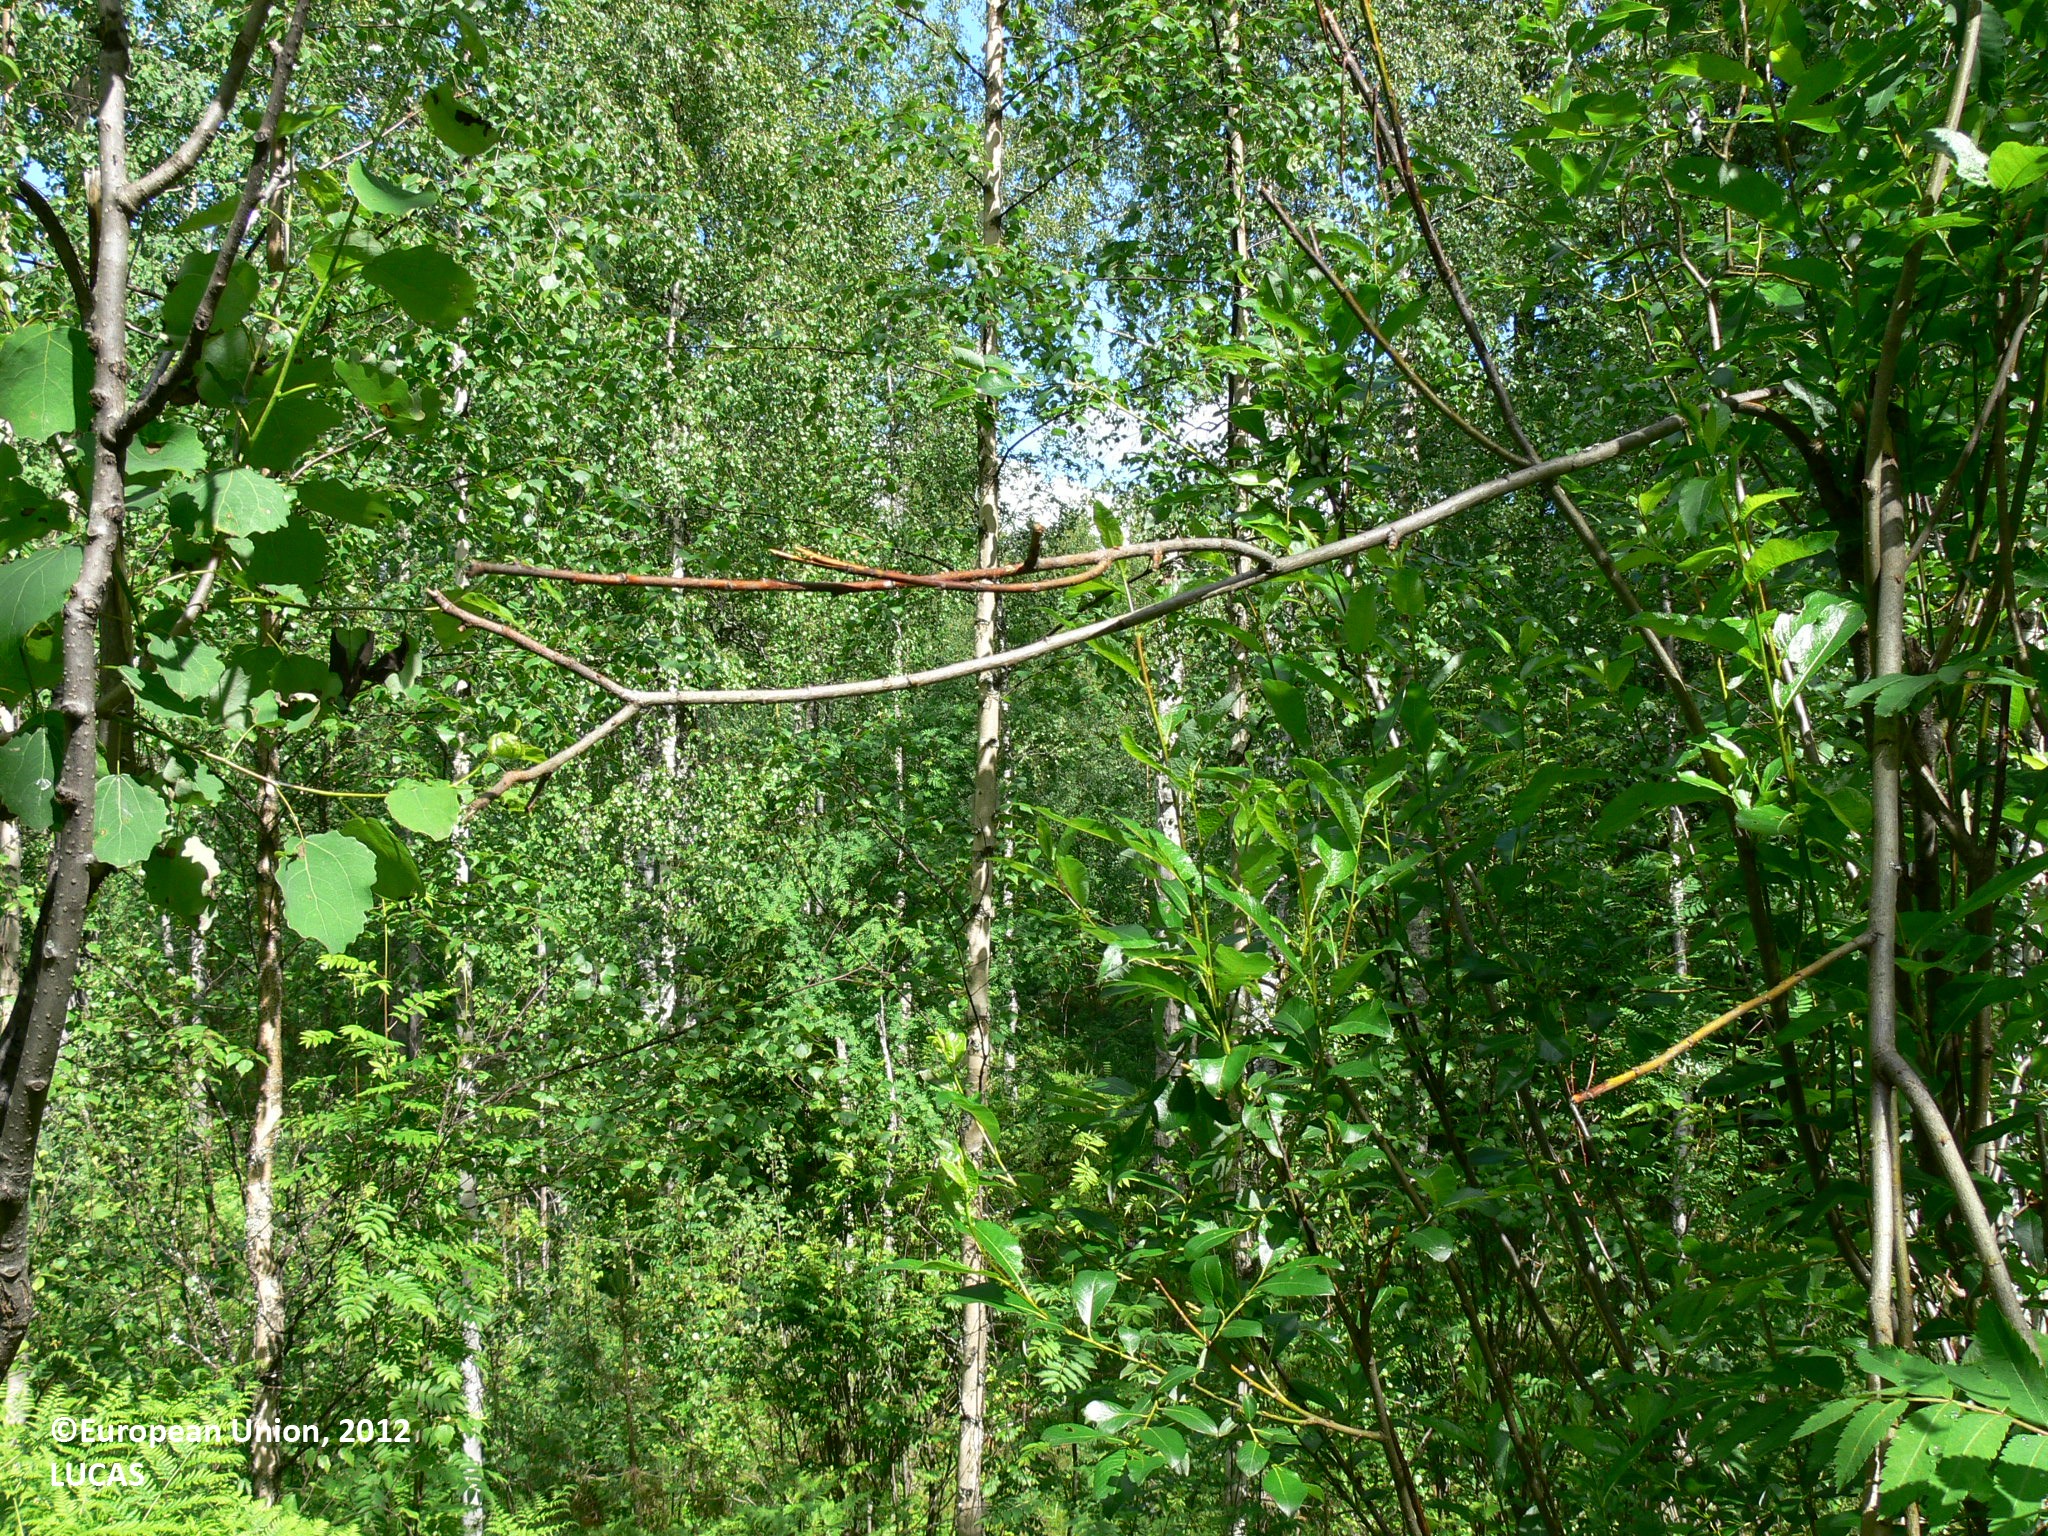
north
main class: Woodland
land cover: Broadleaved woodland
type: boreal forest
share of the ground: 50 - 75 %
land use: Forestry
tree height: > 5 m
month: June
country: FI
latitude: 62.3329
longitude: 30.1327
